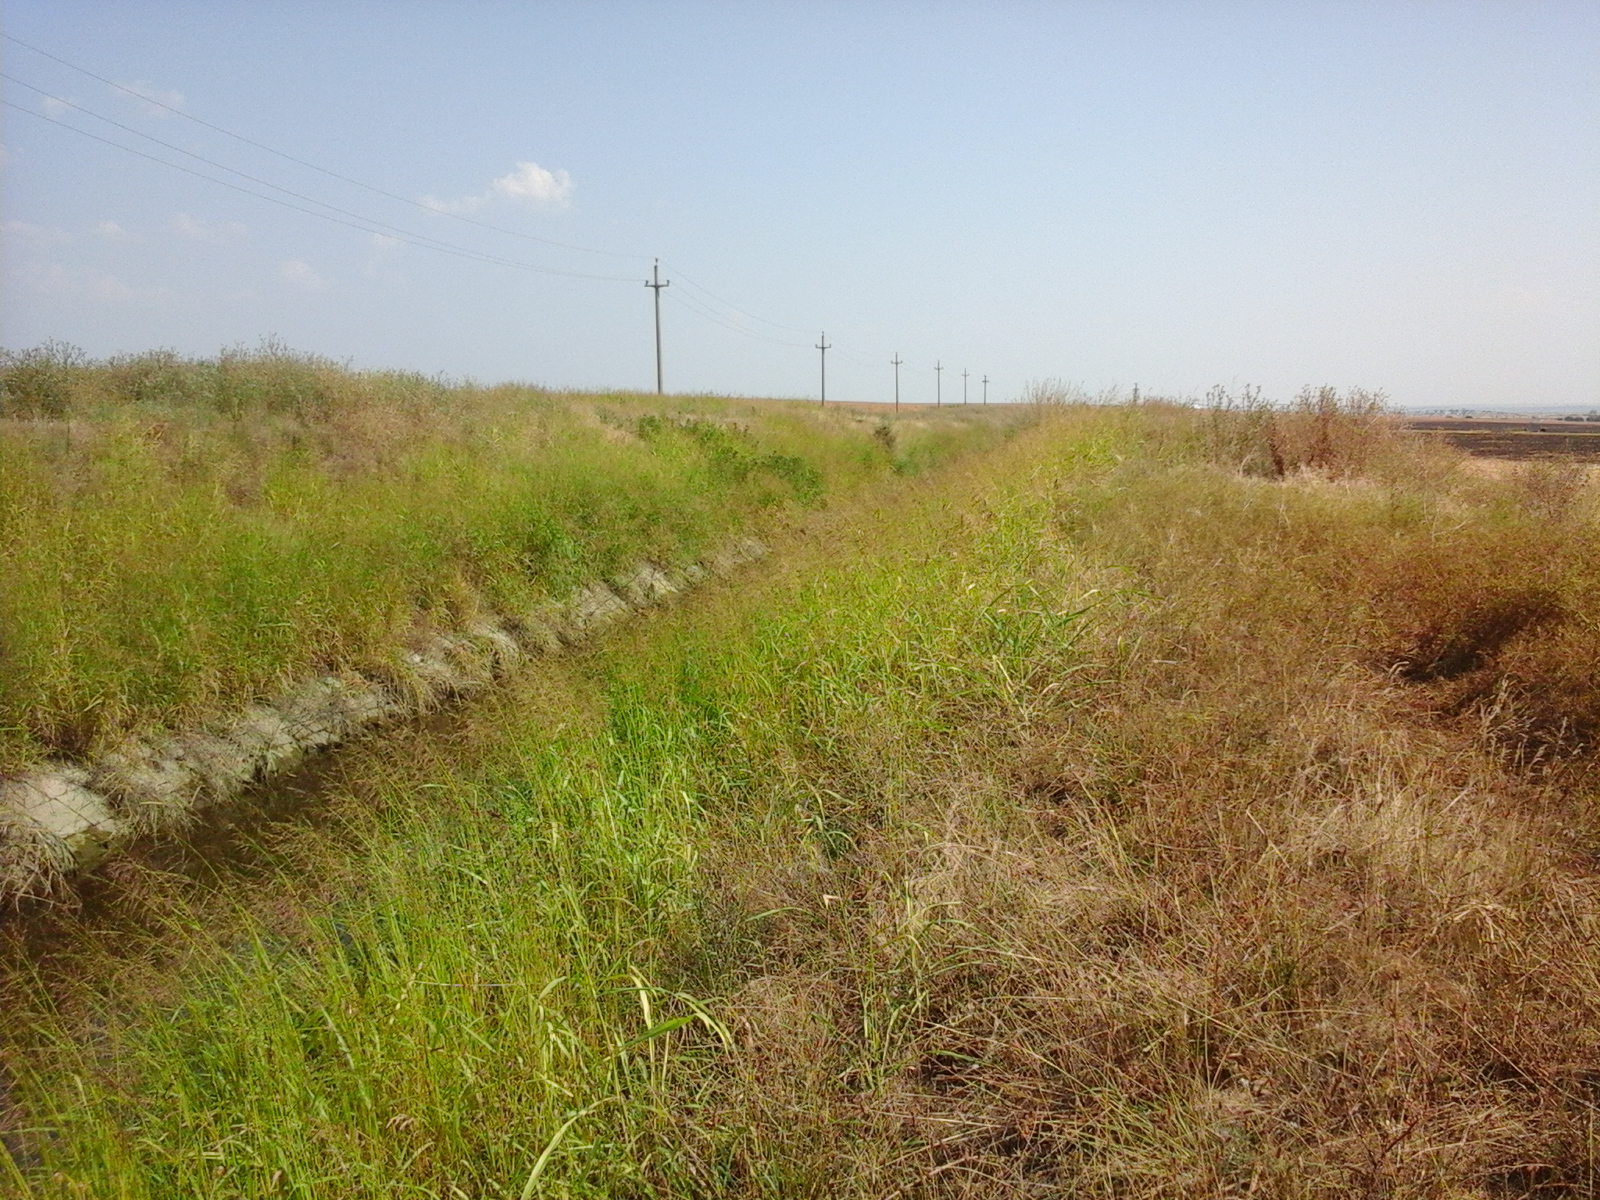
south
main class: Cropland
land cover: Maize
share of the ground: > 75 %
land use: Agriculture (excluding fallow land and kitchen gardens)
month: August
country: RO
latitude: 43.9348
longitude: 23.6670
